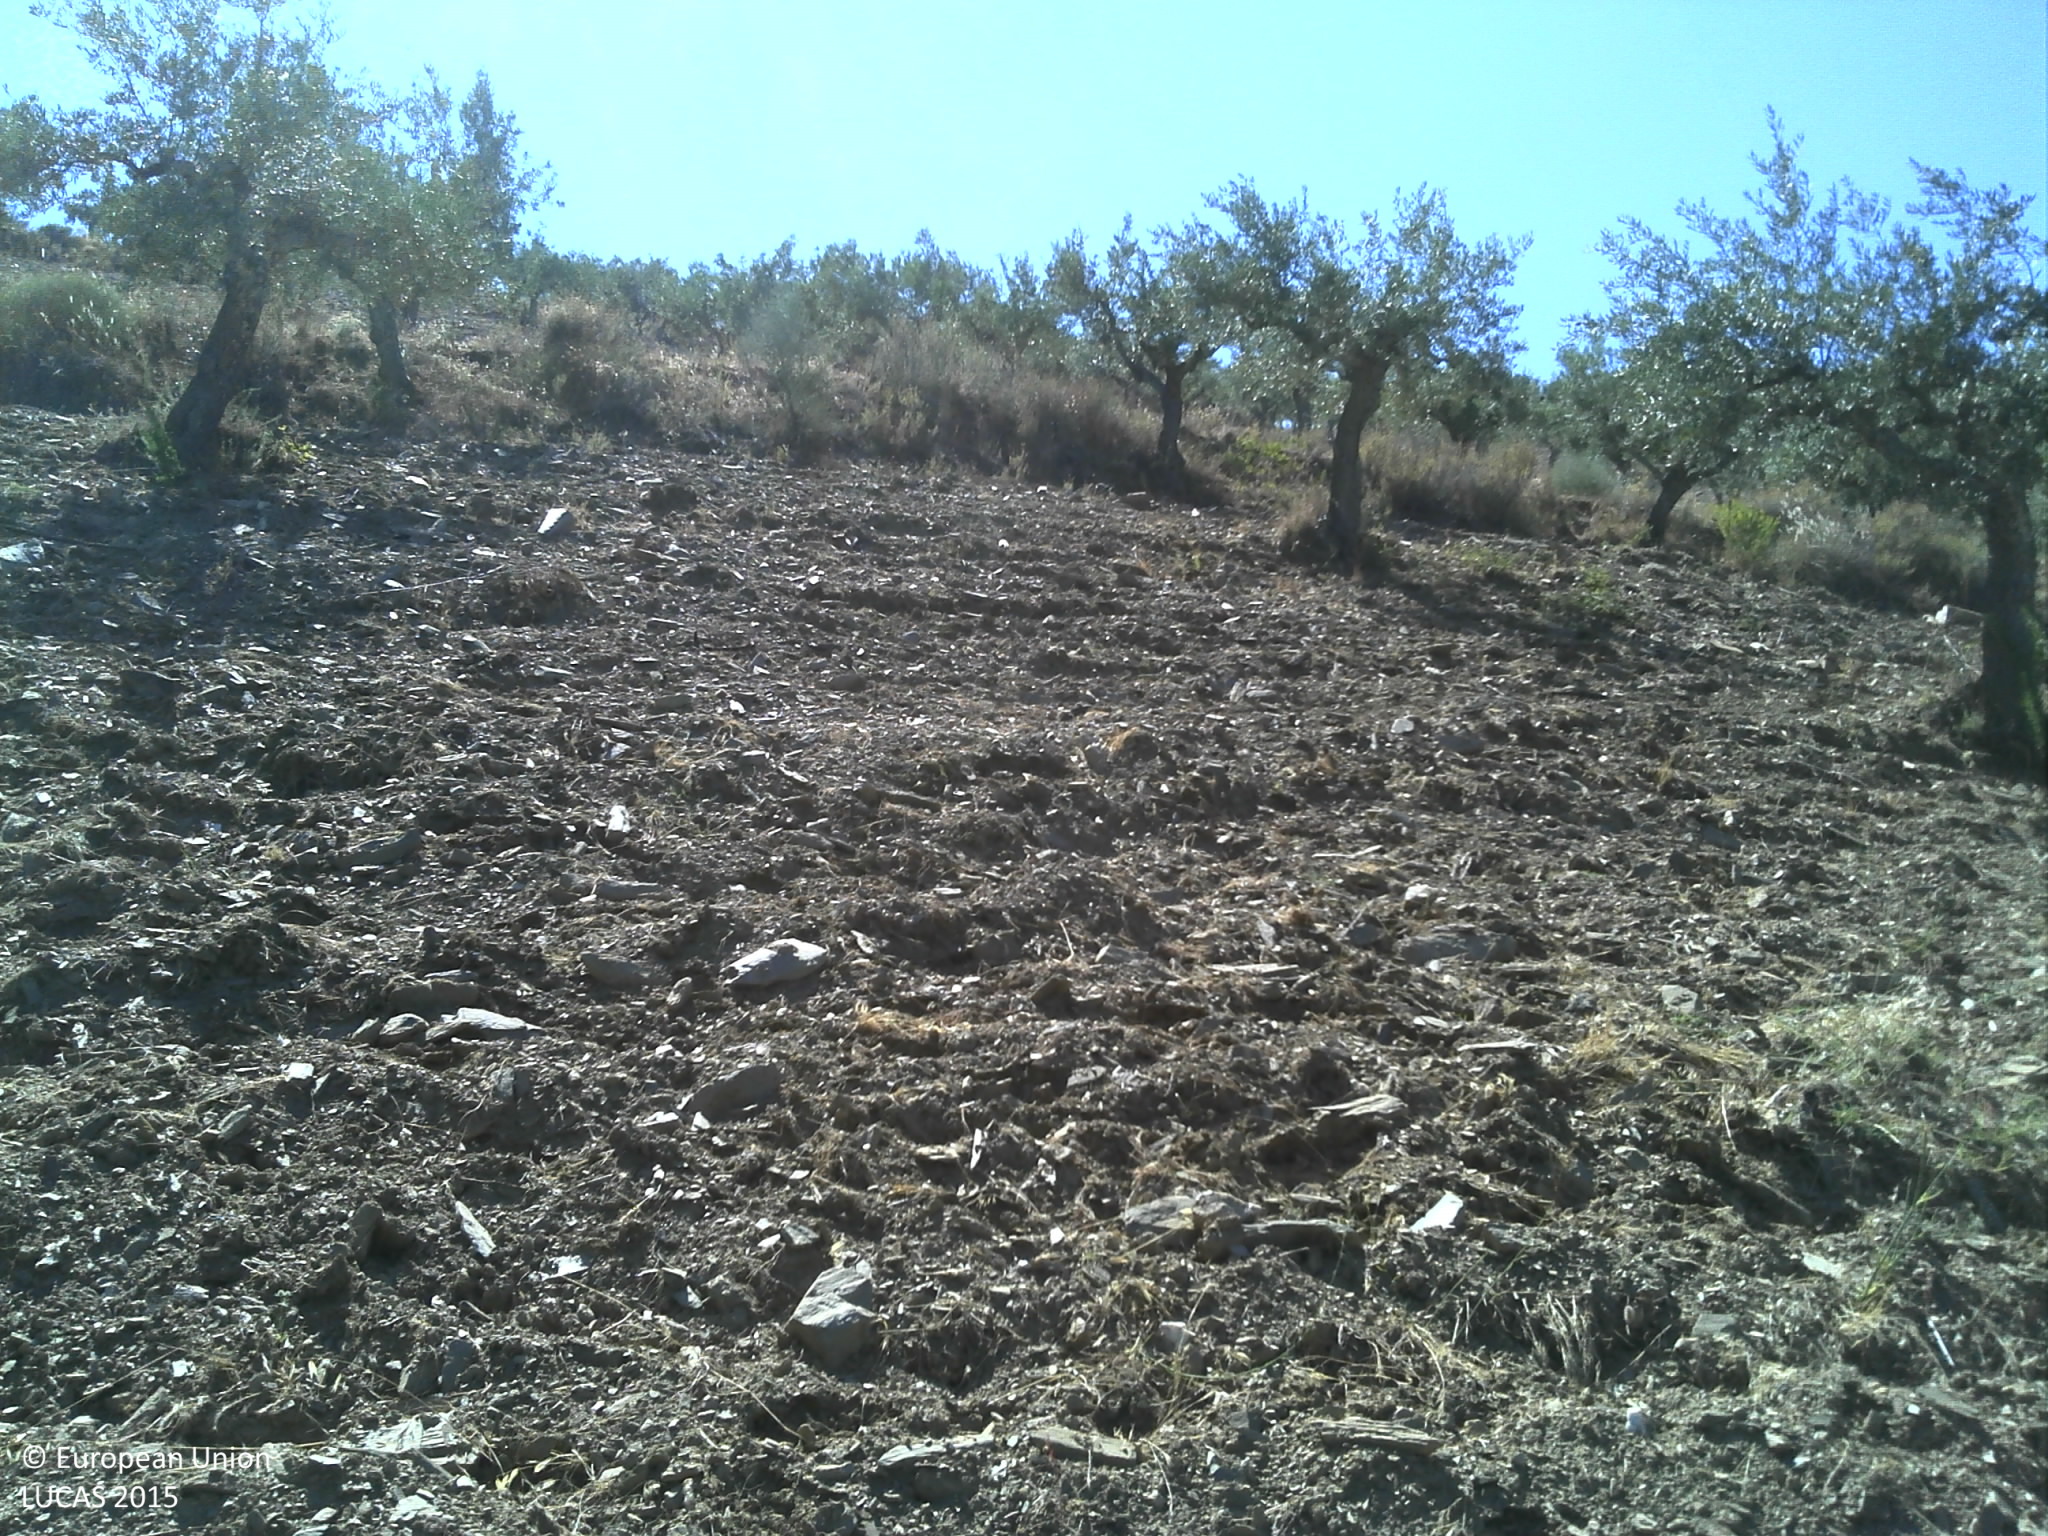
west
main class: Cropland
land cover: Olive groves
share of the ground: < 10 %
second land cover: Other bare soil
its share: > 75 %
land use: Agriculture (excluding fallow land and kitchen gardens)
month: June
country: PT
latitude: 41.0057
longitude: -6.9776
